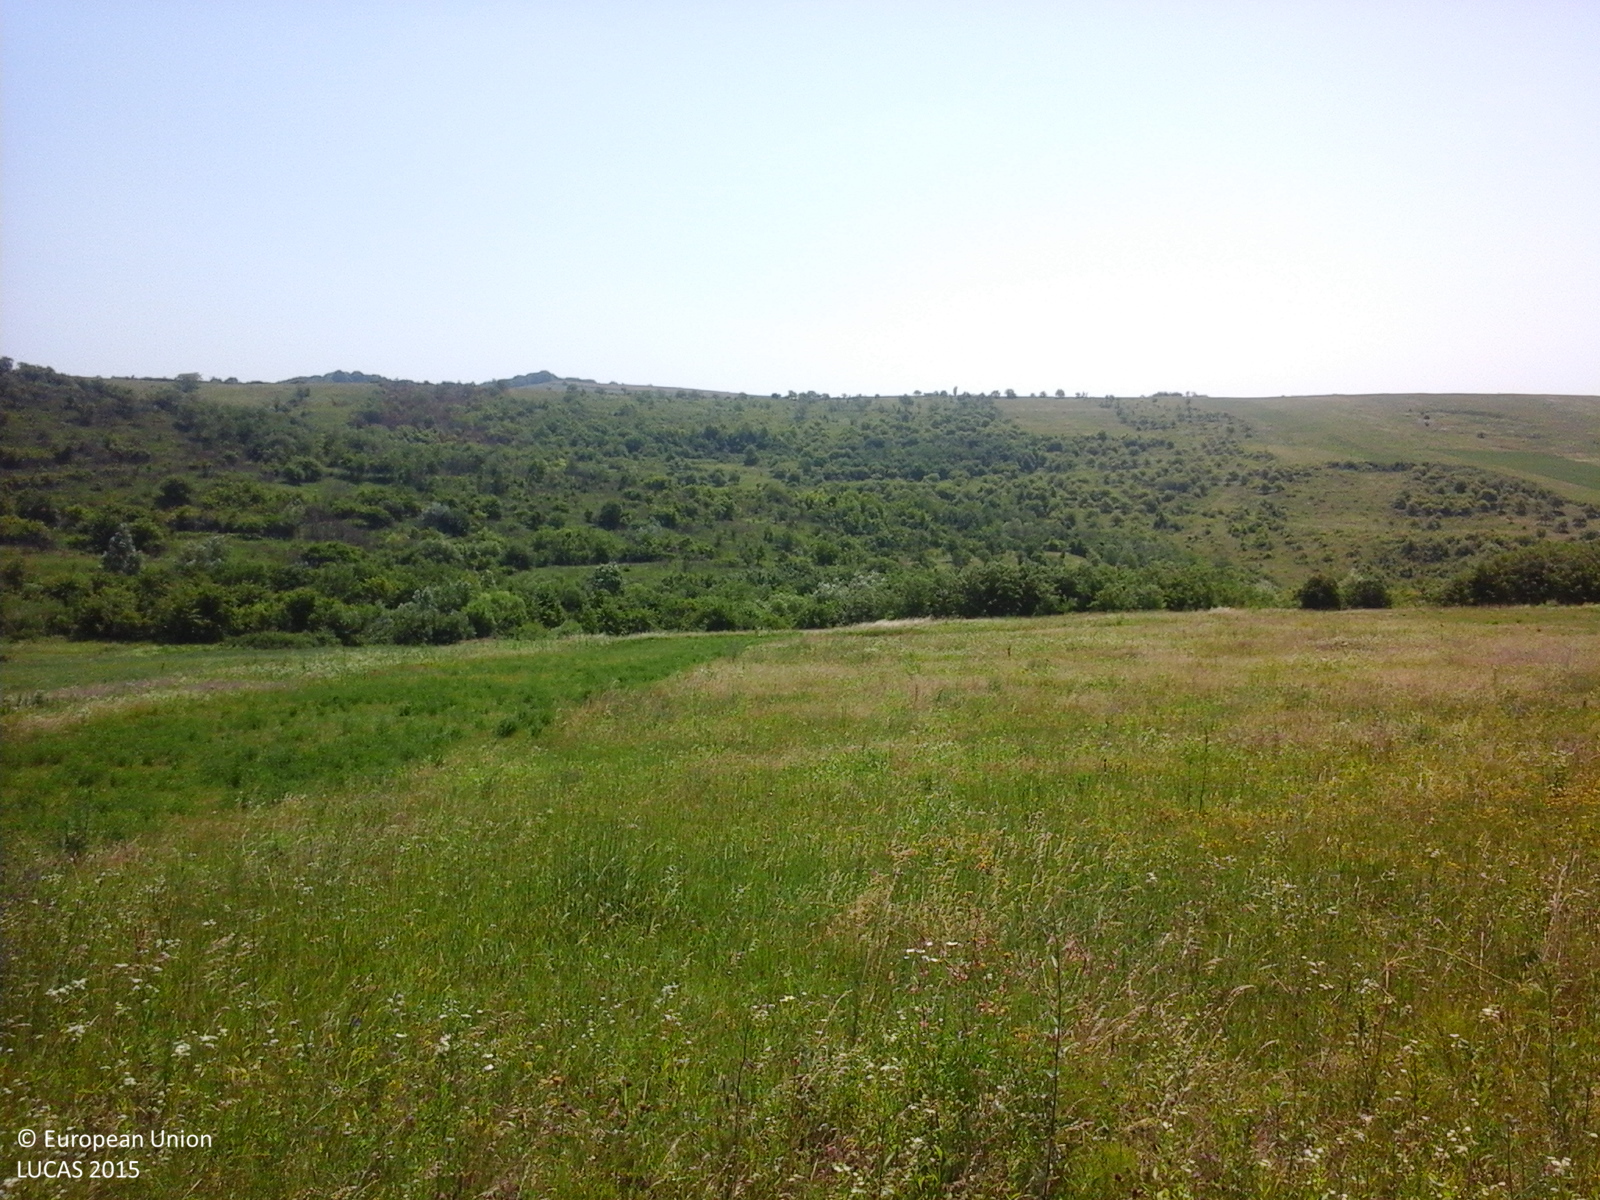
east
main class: Grassland
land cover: Grassland without tree/shrub cover
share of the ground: > 75 %
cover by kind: herbaceous plants 100 %
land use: Agriculture (excluding fallow land and kitchen gardens)
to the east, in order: Grassland without tree/shrub cover; Other leguminous and mixtures for fodder; Broadleaved woodland
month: June
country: RO
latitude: 46.7199
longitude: 27.2569
